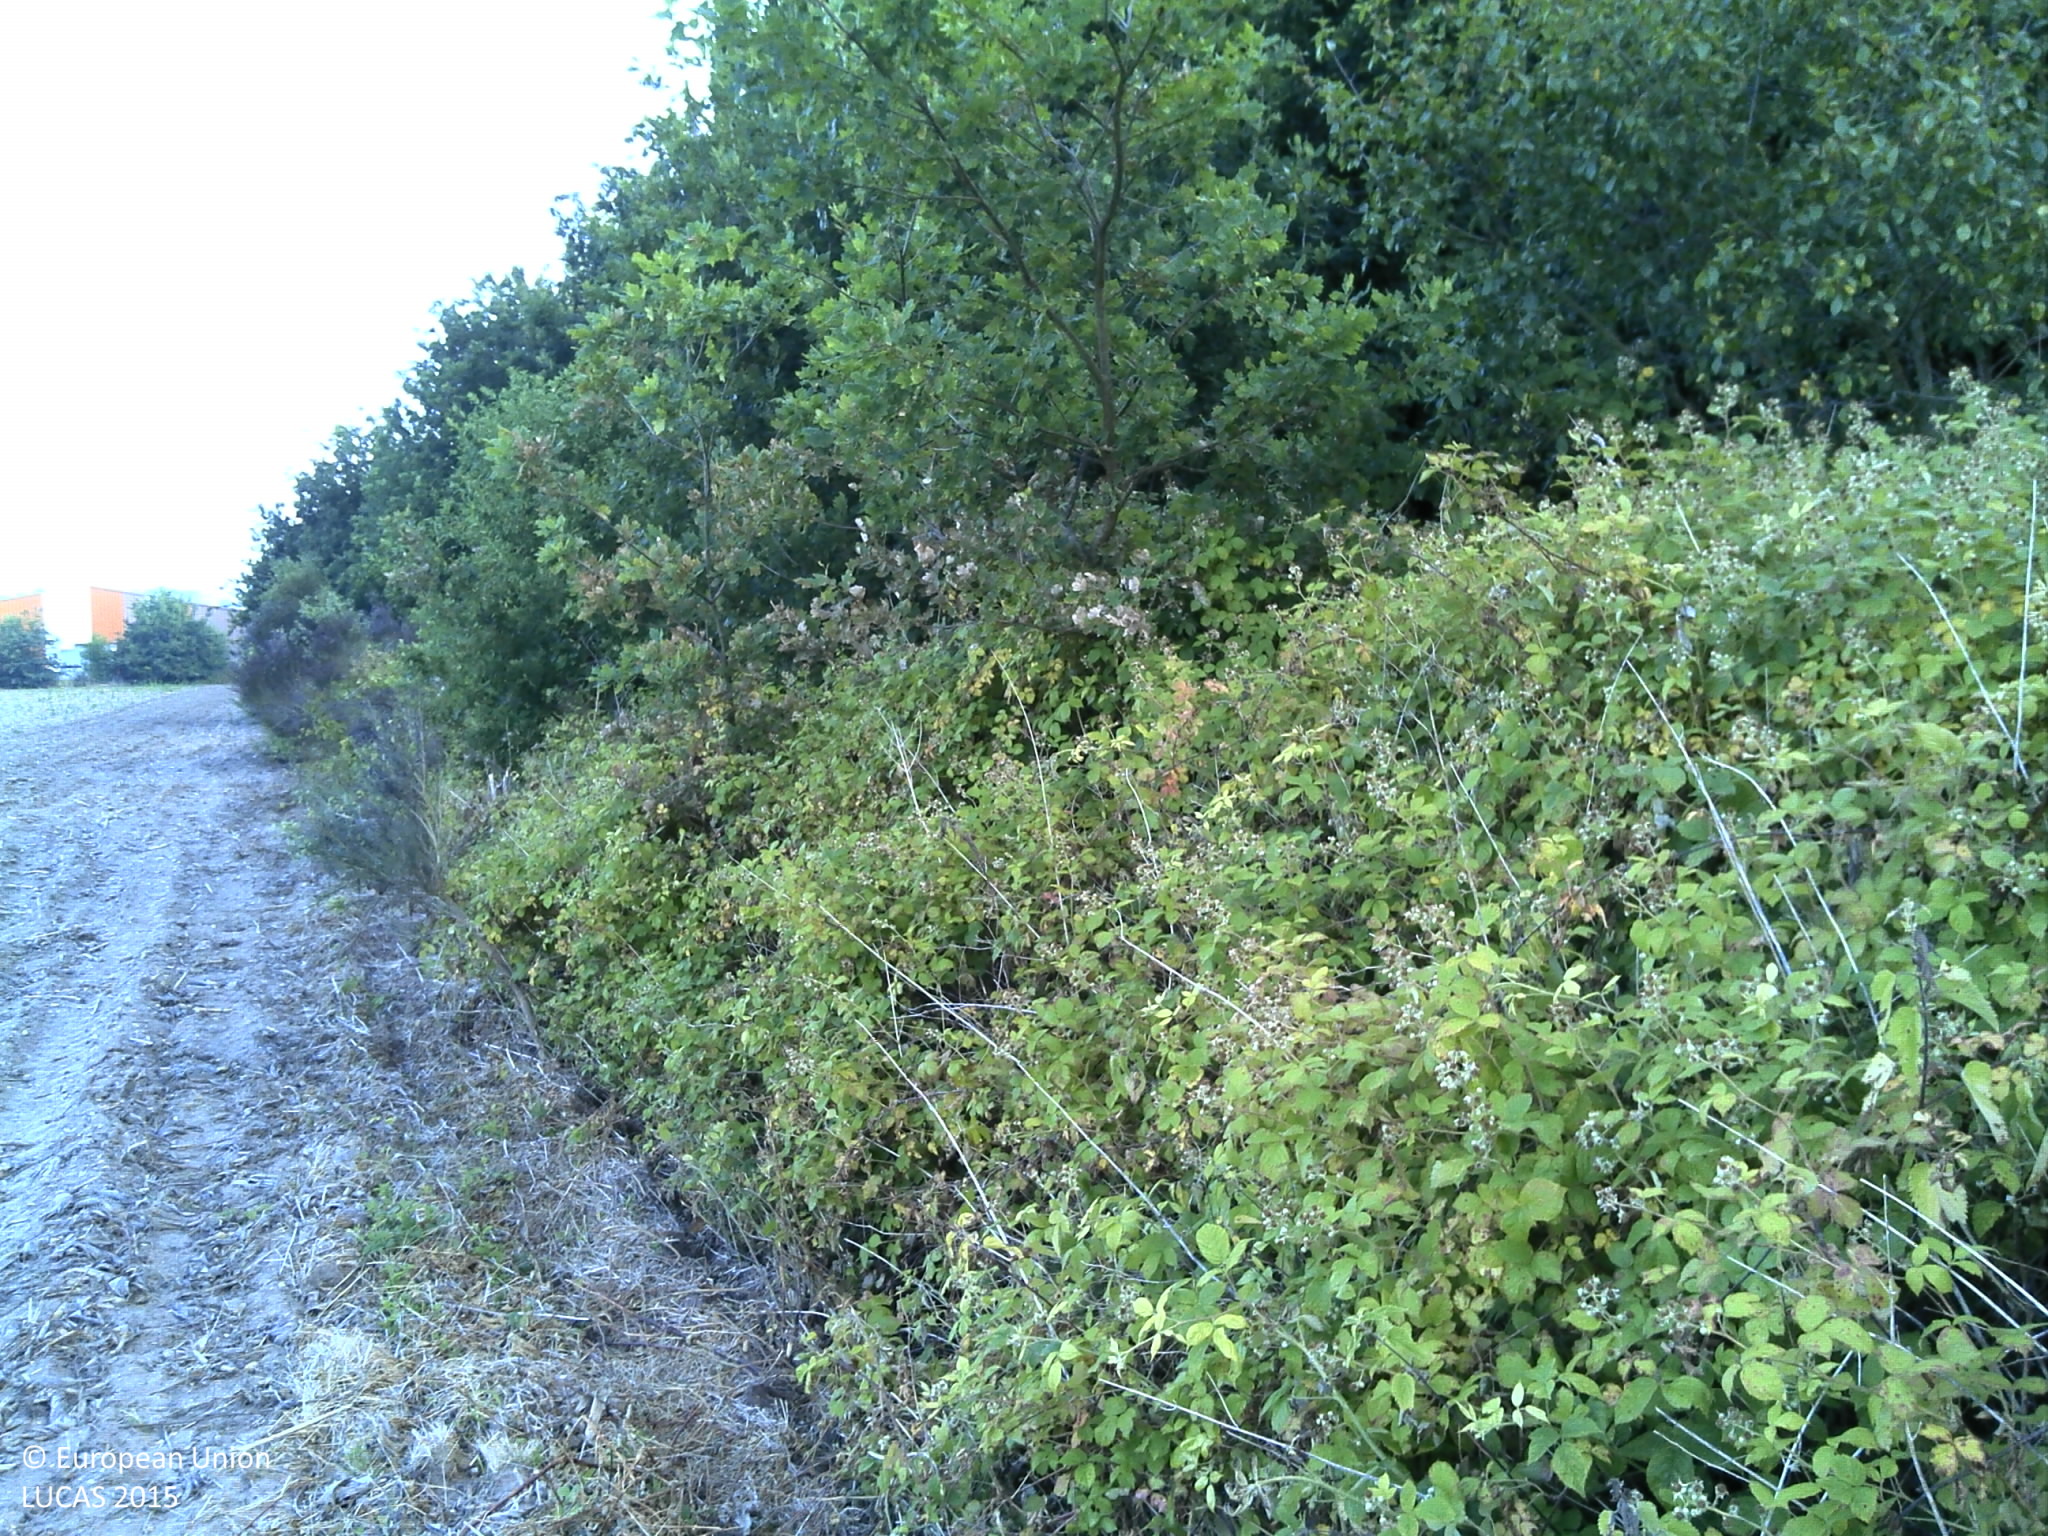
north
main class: Woodland
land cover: Broadleaved woodland
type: acidophilous oak and oak-birch forest
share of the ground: > 75 %
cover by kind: broadleaved forest trees 100 %
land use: Forestry
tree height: > 5 m
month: June
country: FR
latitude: 49.2893
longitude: 1.0554
